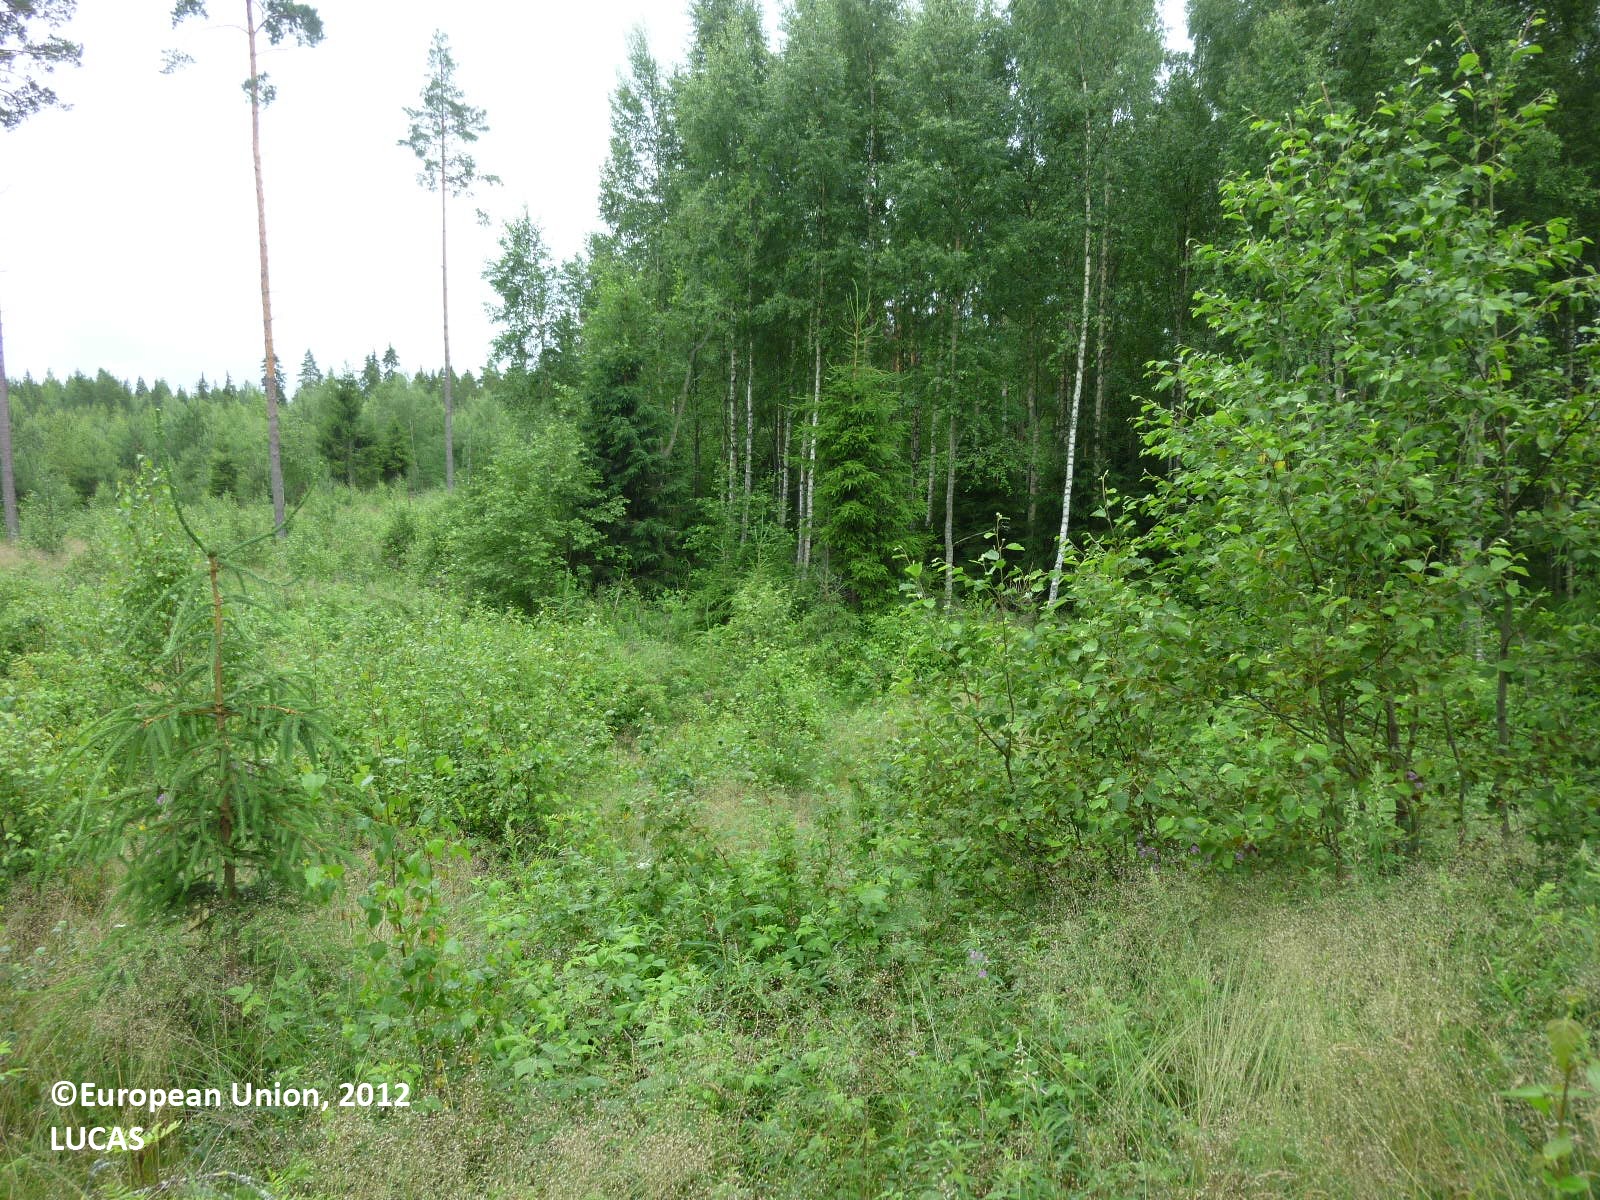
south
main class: Woodland
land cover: Broadleaved woodland
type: boreal forest
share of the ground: > 75 %
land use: Forestry
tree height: > 5 m
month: July
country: FI
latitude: 61.4741
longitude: 22.2044
